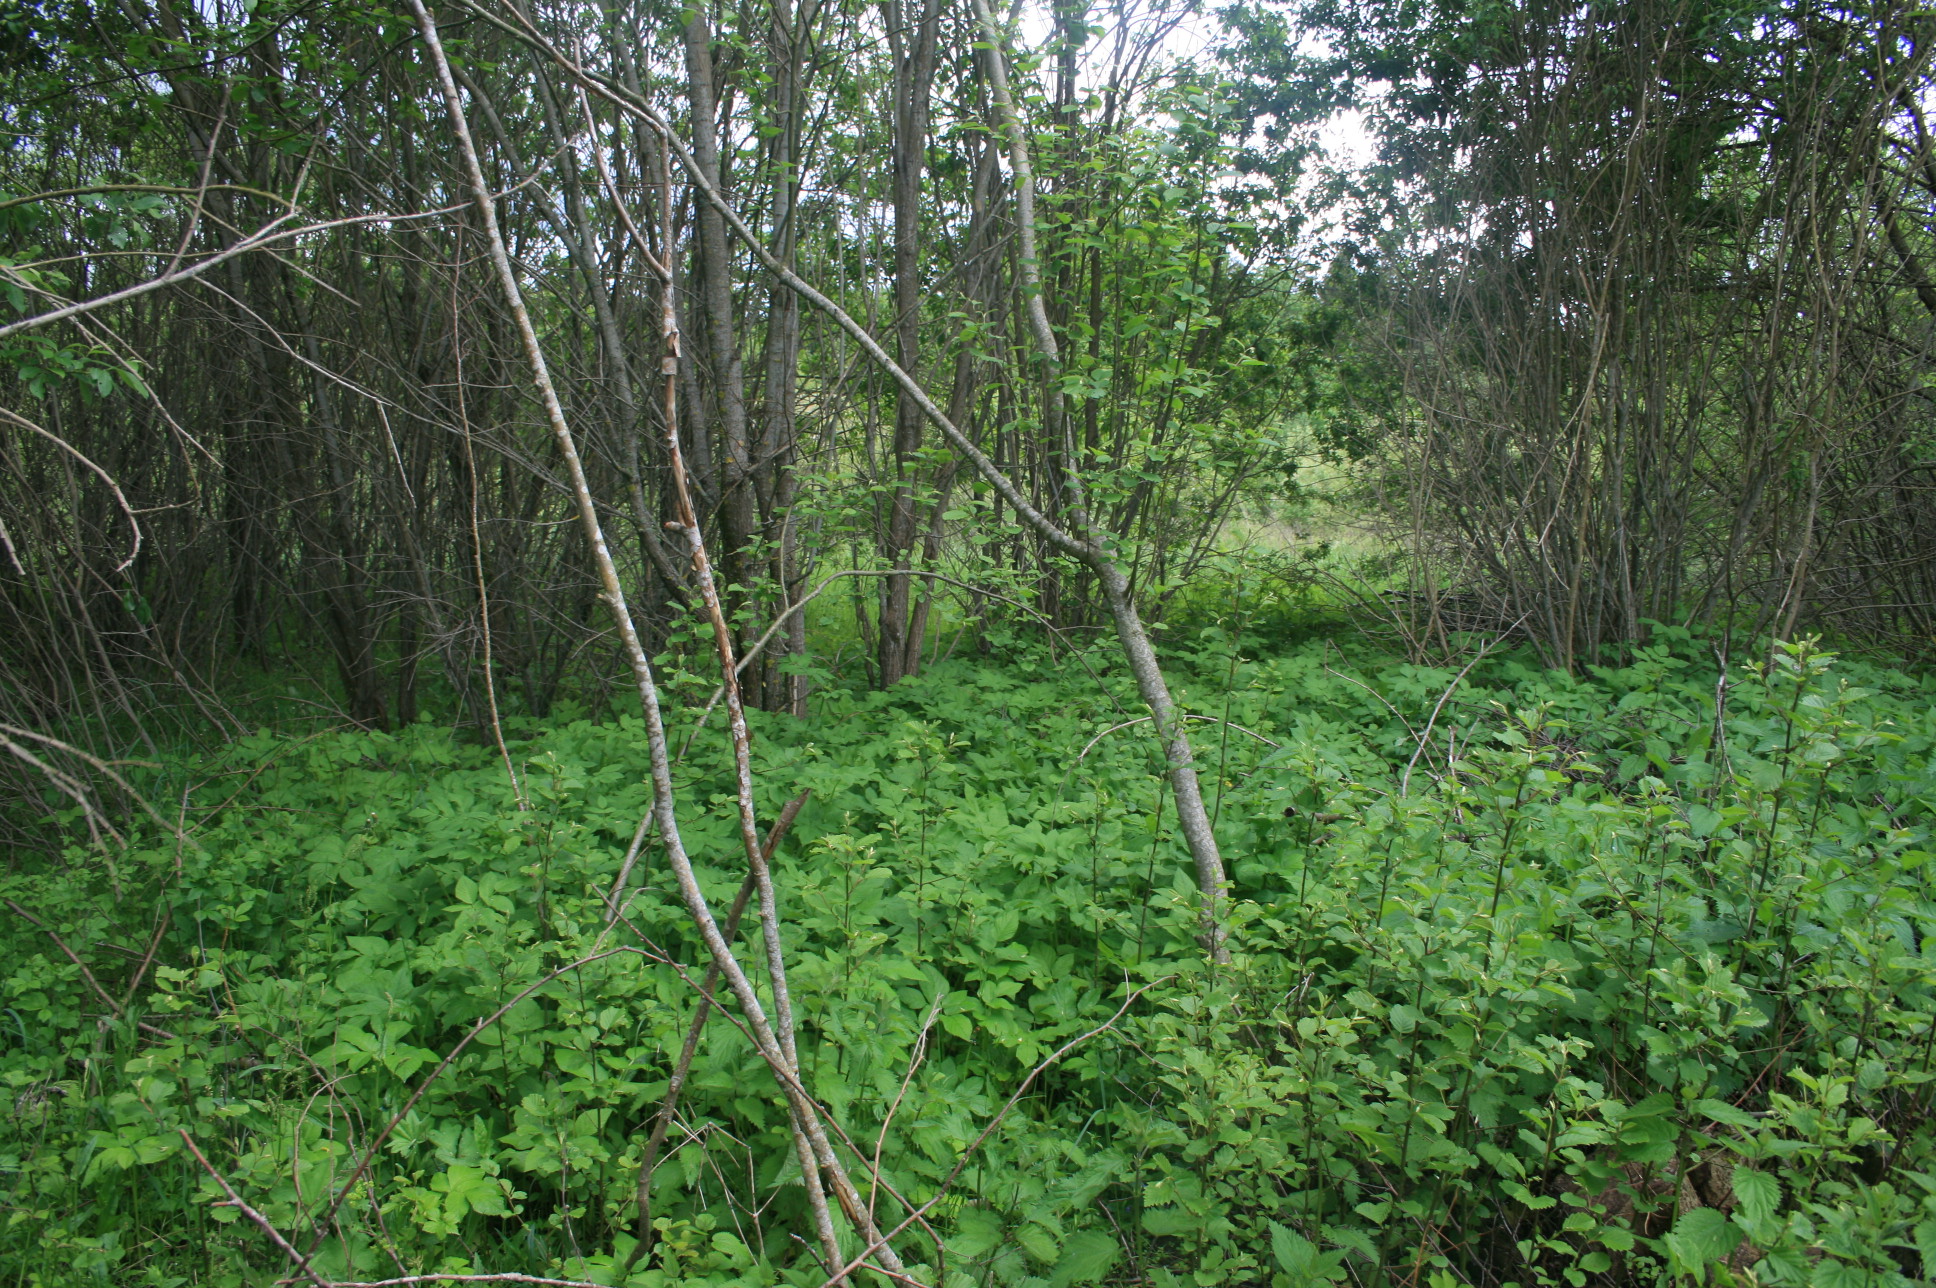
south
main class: Woodland
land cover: Broadleaved woodland
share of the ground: > 75 %
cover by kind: broadleaved forest trees 85 %, herbaceous plants 15 %
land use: Semi-natural and natural areas not in use
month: May
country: LT
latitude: 55.9485
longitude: 22.0138
